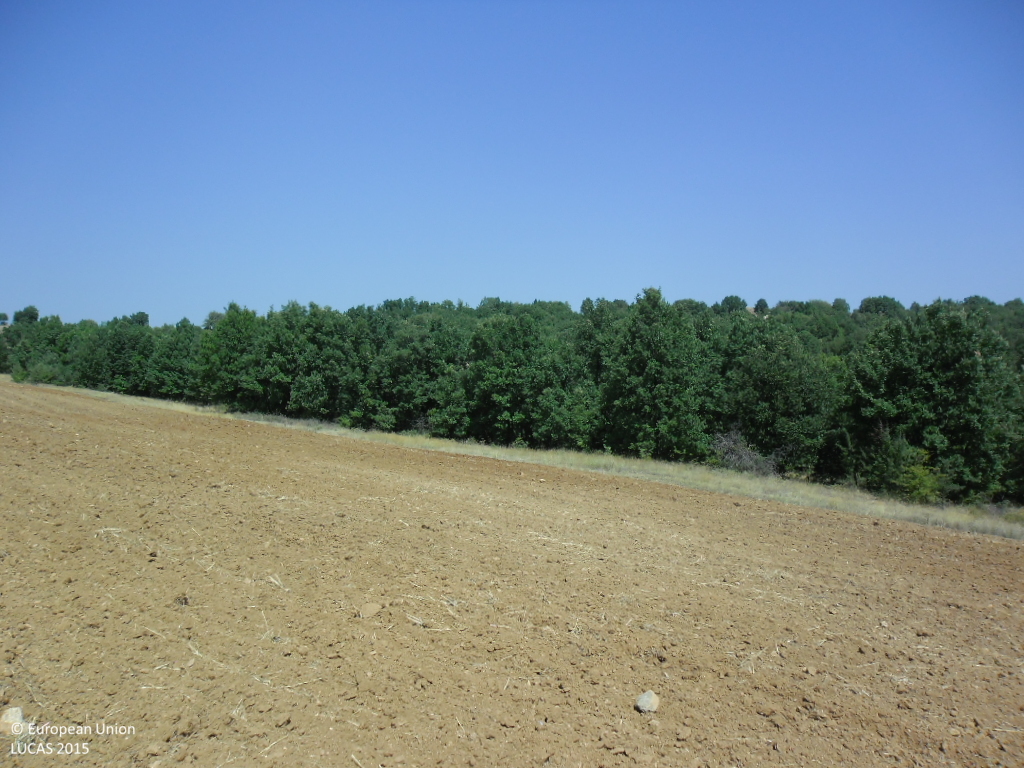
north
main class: Cropland
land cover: Common wheat
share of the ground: < 10 %
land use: Agriculture (excluding fallow land and kitchen gardens)
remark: Harvested field
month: August
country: BG
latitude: 42.0012
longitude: 22.9524
